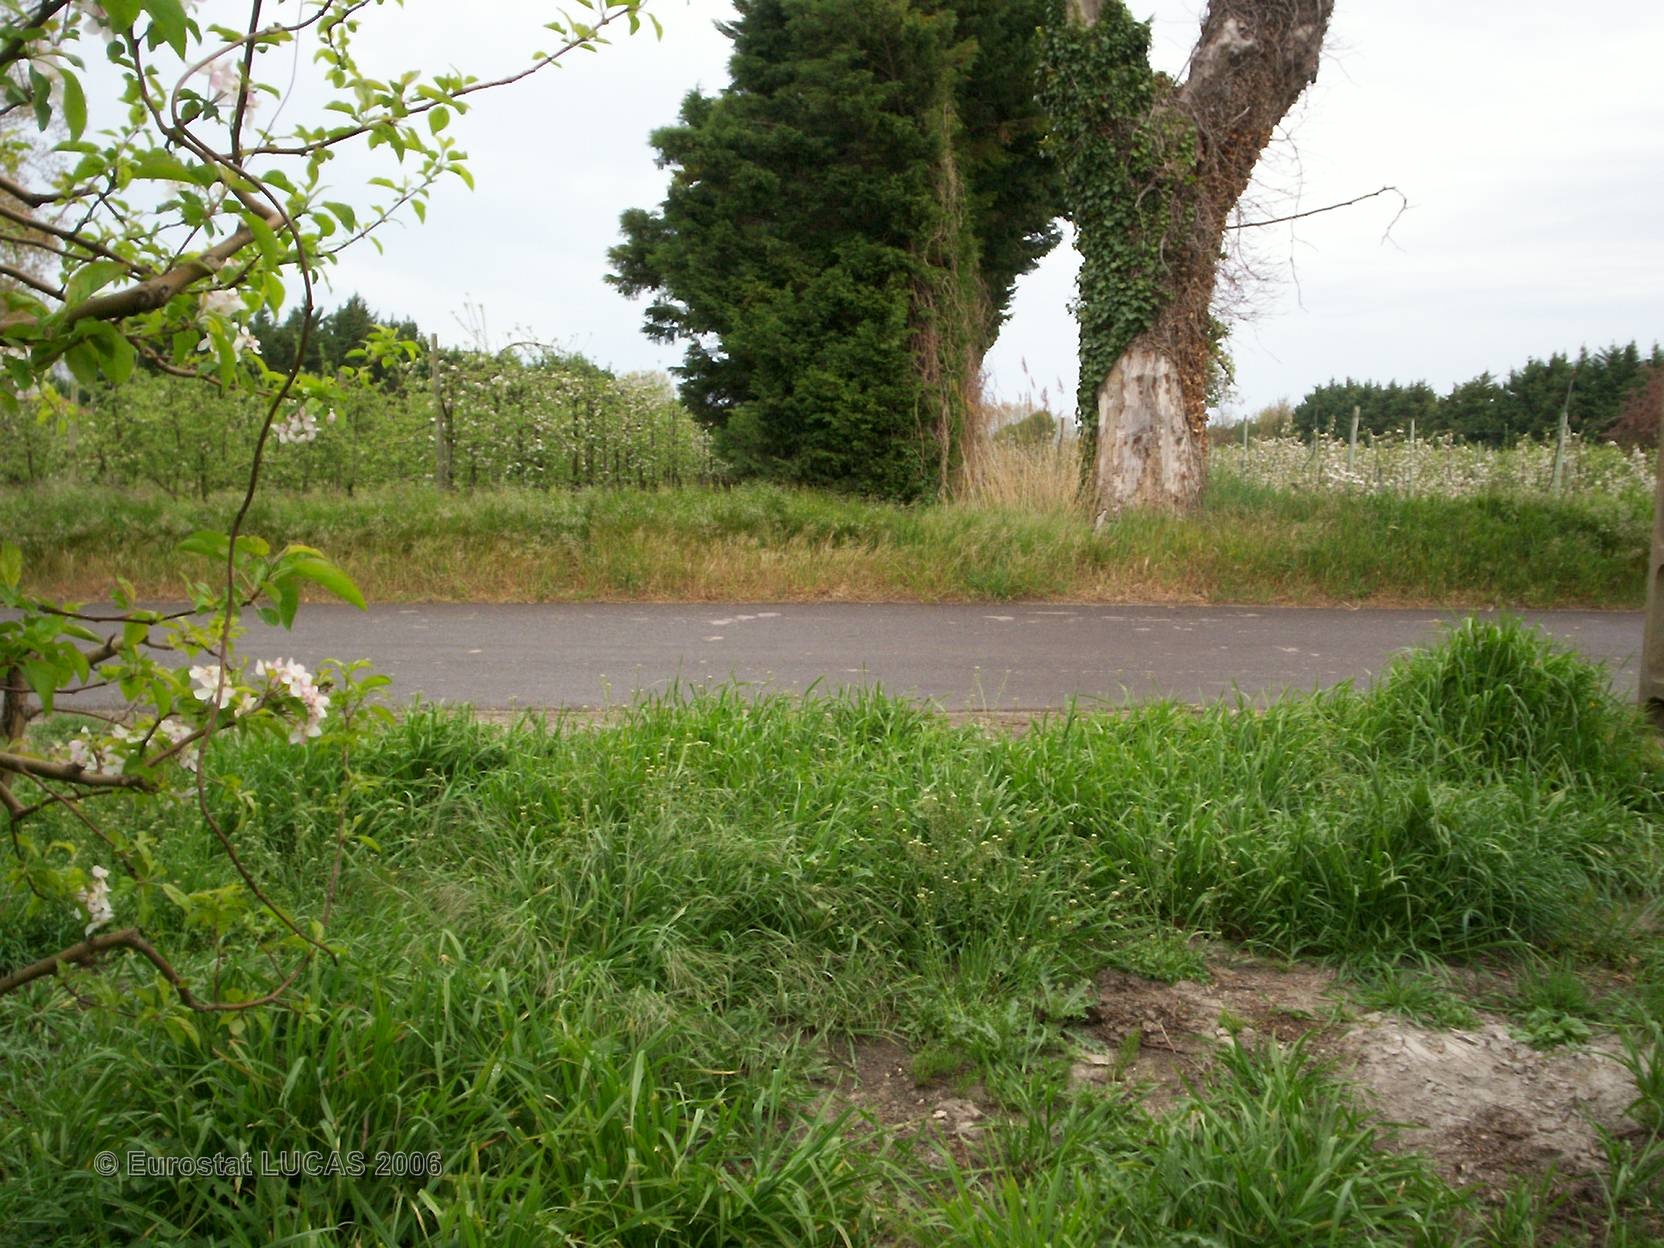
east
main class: Cropland
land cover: Apple fruit
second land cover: Grassland with sparse tree/shrub cover
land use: Agriculture (excluding fallow land and kitchen gardens)
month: April
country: FR
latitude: 43.8095
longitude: 4.8998
